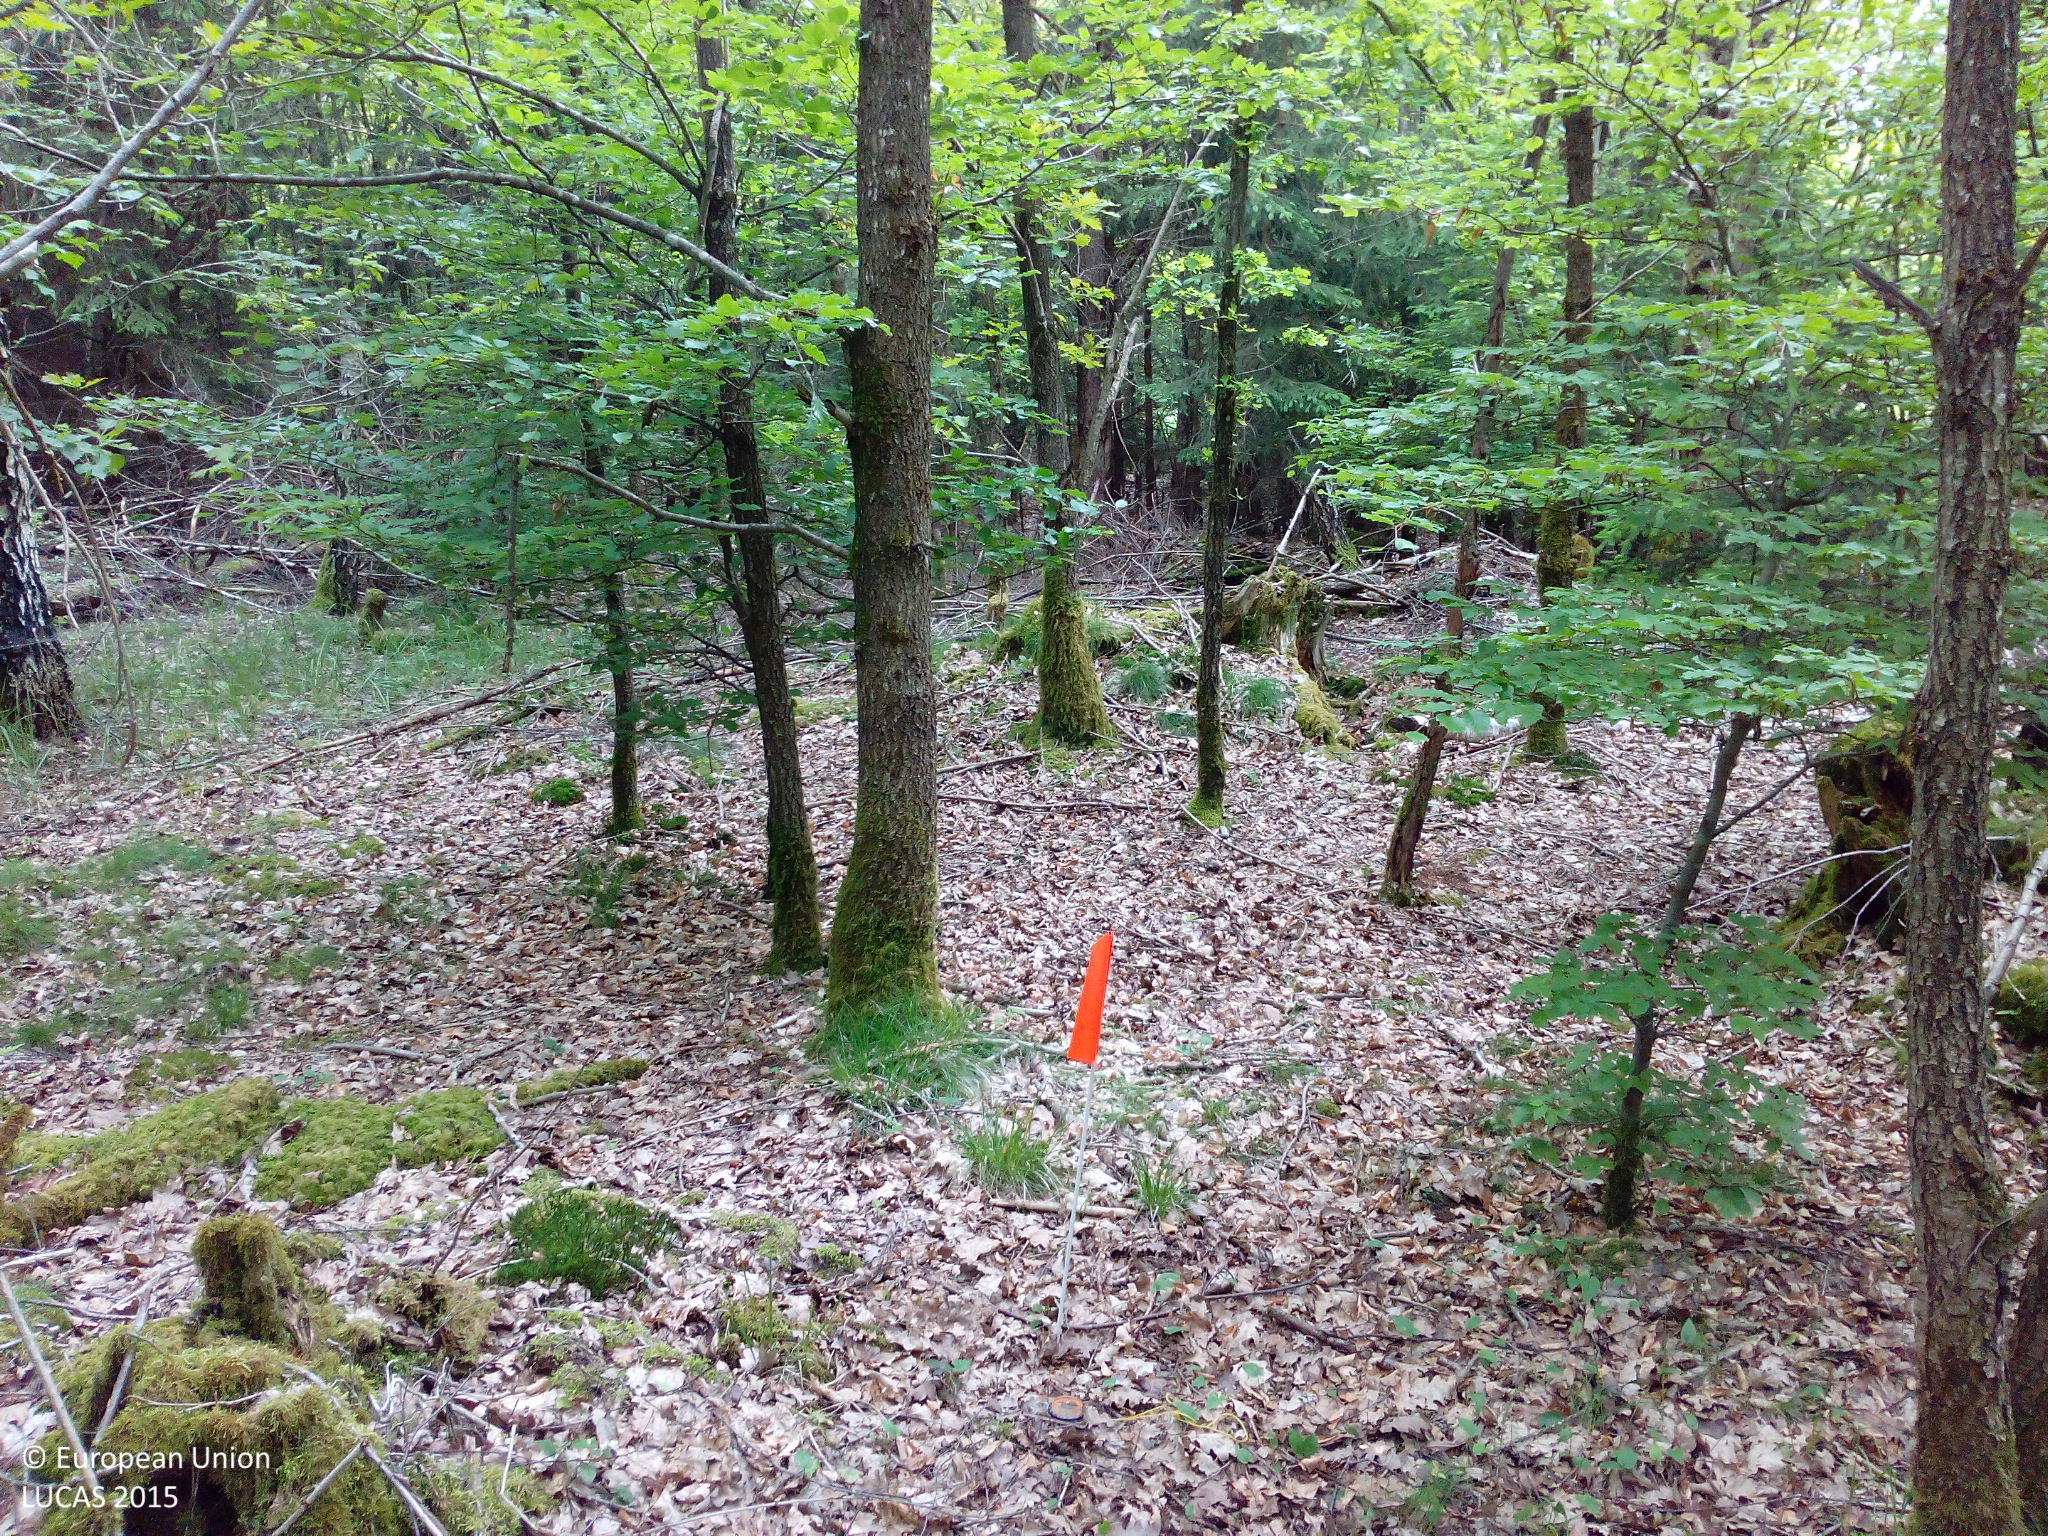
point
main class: Woodland
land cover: Spruce dominated mixed woodland
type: hemiboreal forest and nemoral coniferous forest and mixed broadleaved-coniferous forest
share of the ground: > 75 %
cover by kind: coniferous forest trees 75 %, broadleaved forest trees 25 %
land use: Forestry
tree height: > 5 m
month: May
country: DE
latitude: 48.0684
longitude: 11.5692
